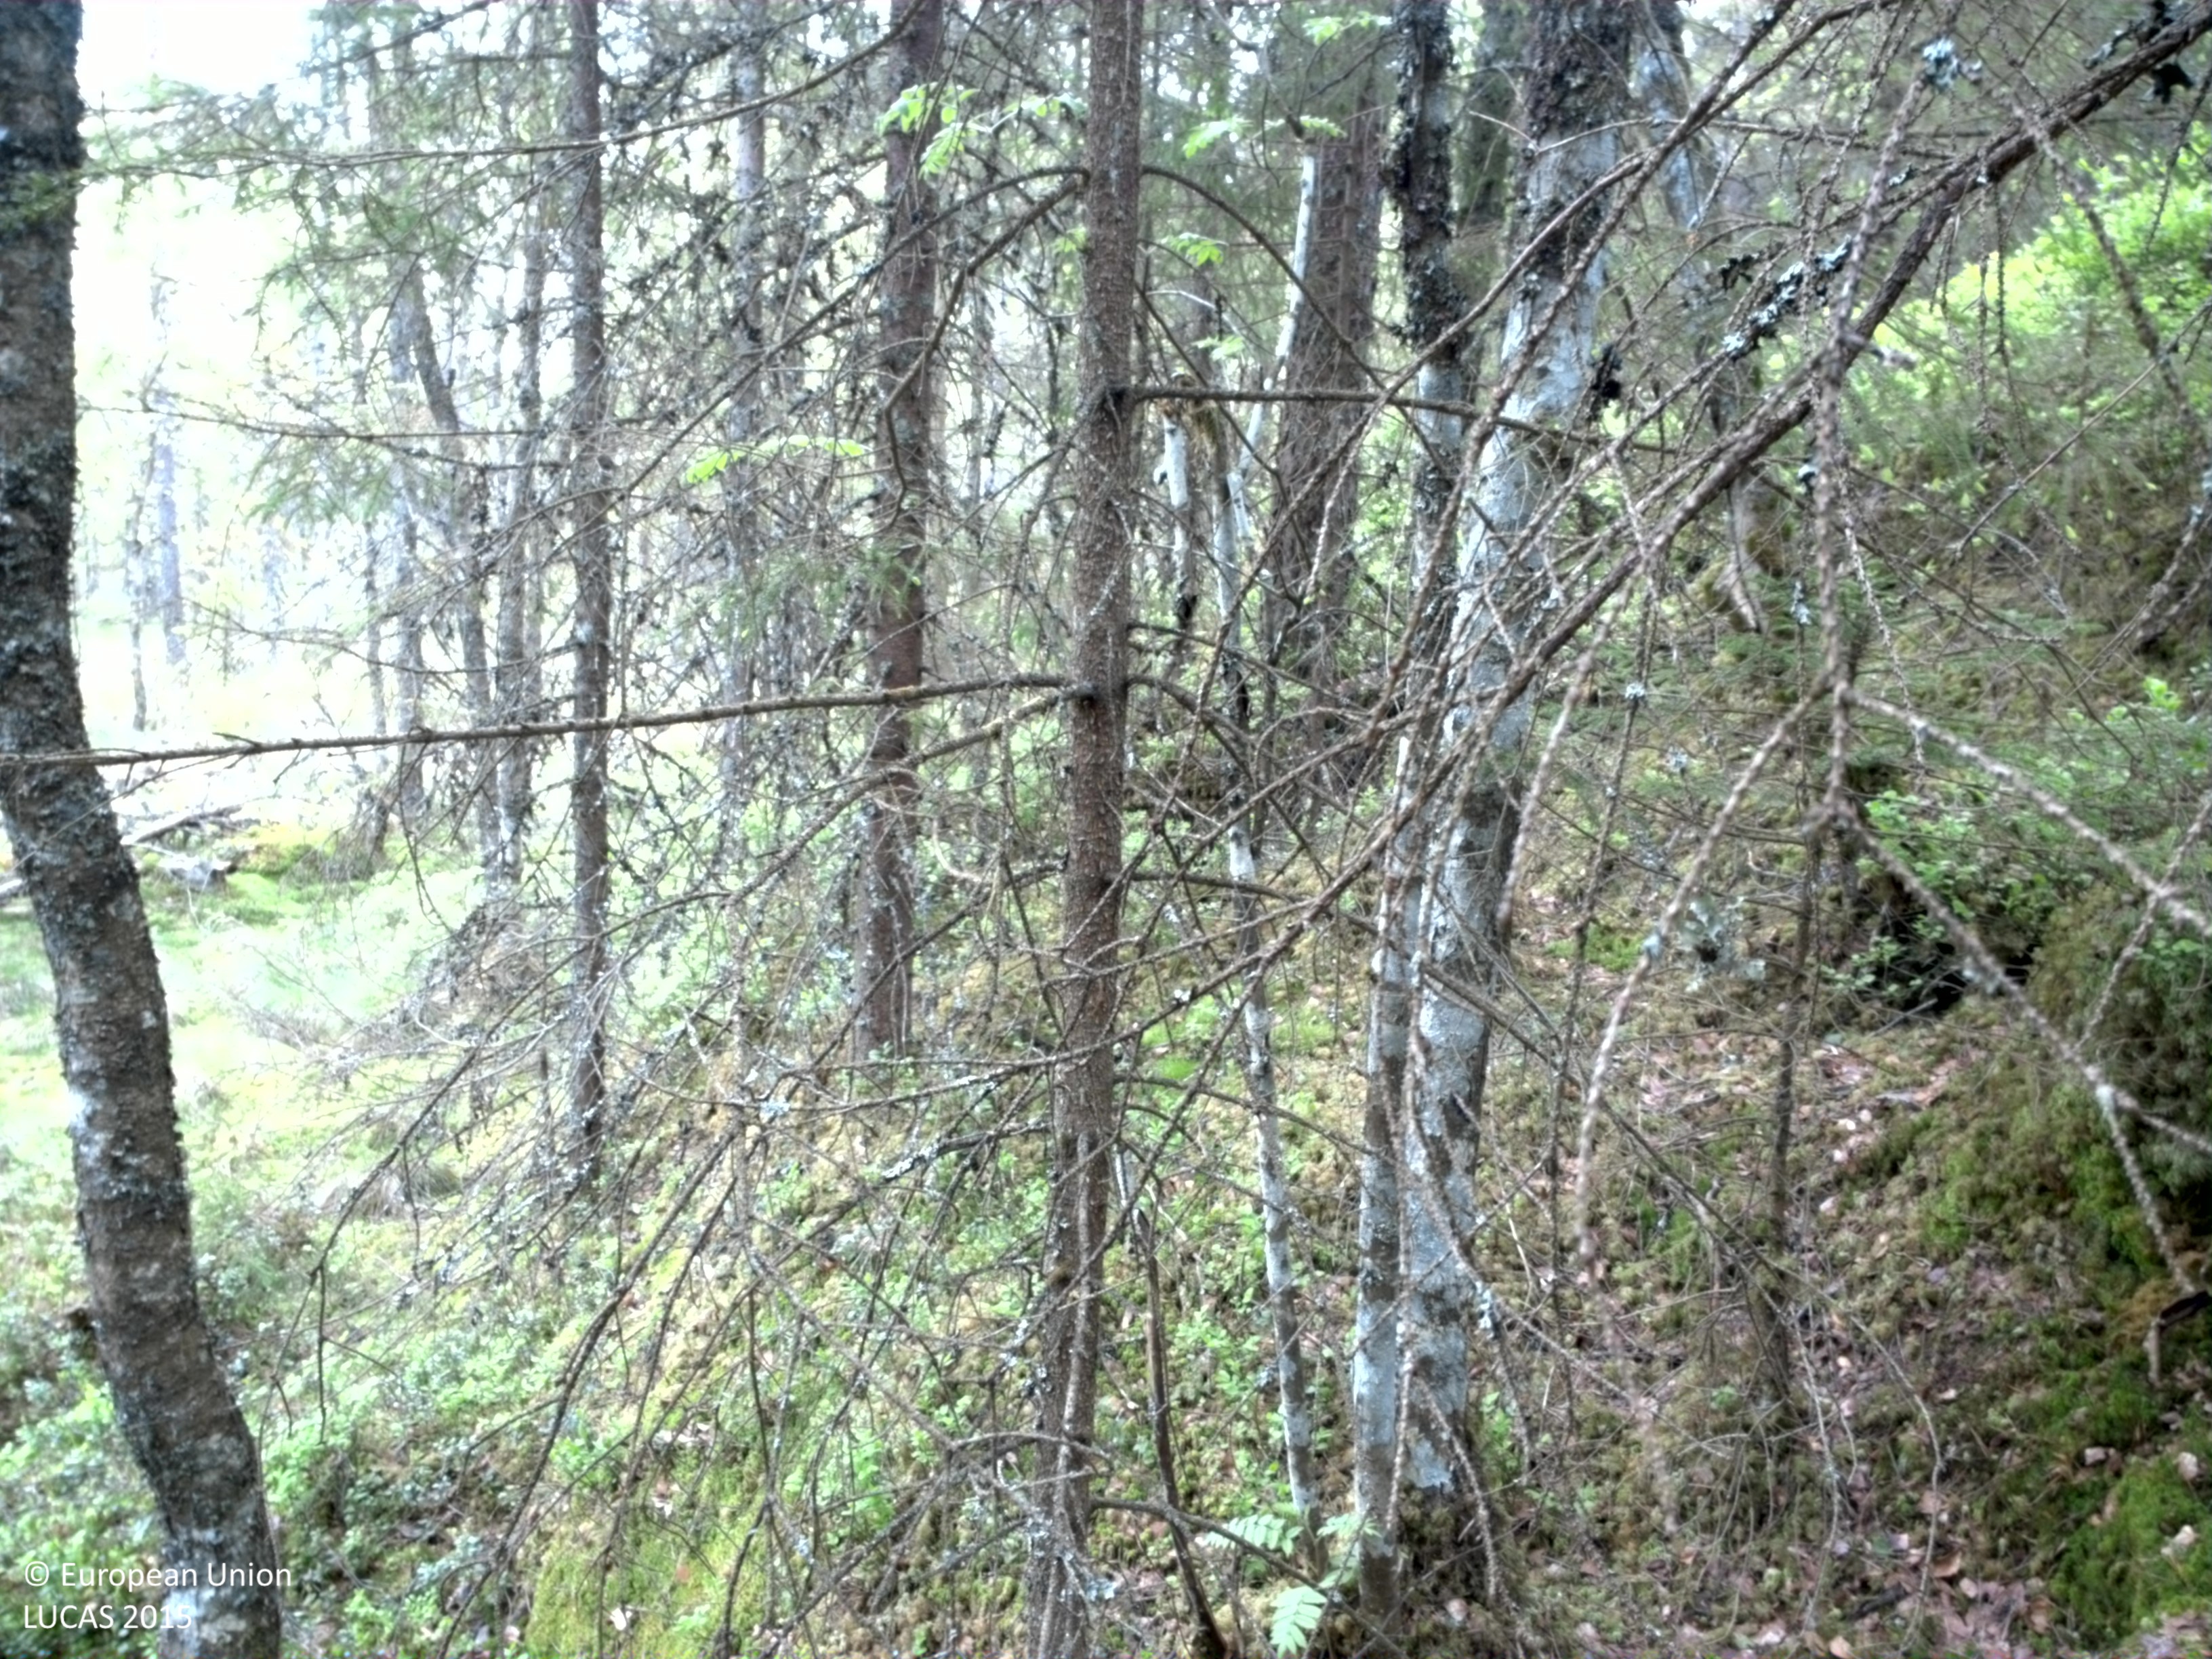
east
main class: Woodland
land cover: Spruce dominated coniferous woodland
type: boreal forest
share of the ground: 50 - 75 %
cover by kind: coniferous forest trees 60 %, shrubs 25 %, broadleaved forest trees 15 %
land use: Forestry
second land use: Amenities, museums, leisure
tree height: > 5 m
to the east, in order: Spruce dominated coniferous woodland; Tracks; Pine dominated mixed woodland; Peatbogs; Spruce dominated coniferous woodland; Peatbogs; Spruce dominated coniferous woodland
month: June
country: SE
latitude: 57.4623
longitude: 13.8463
